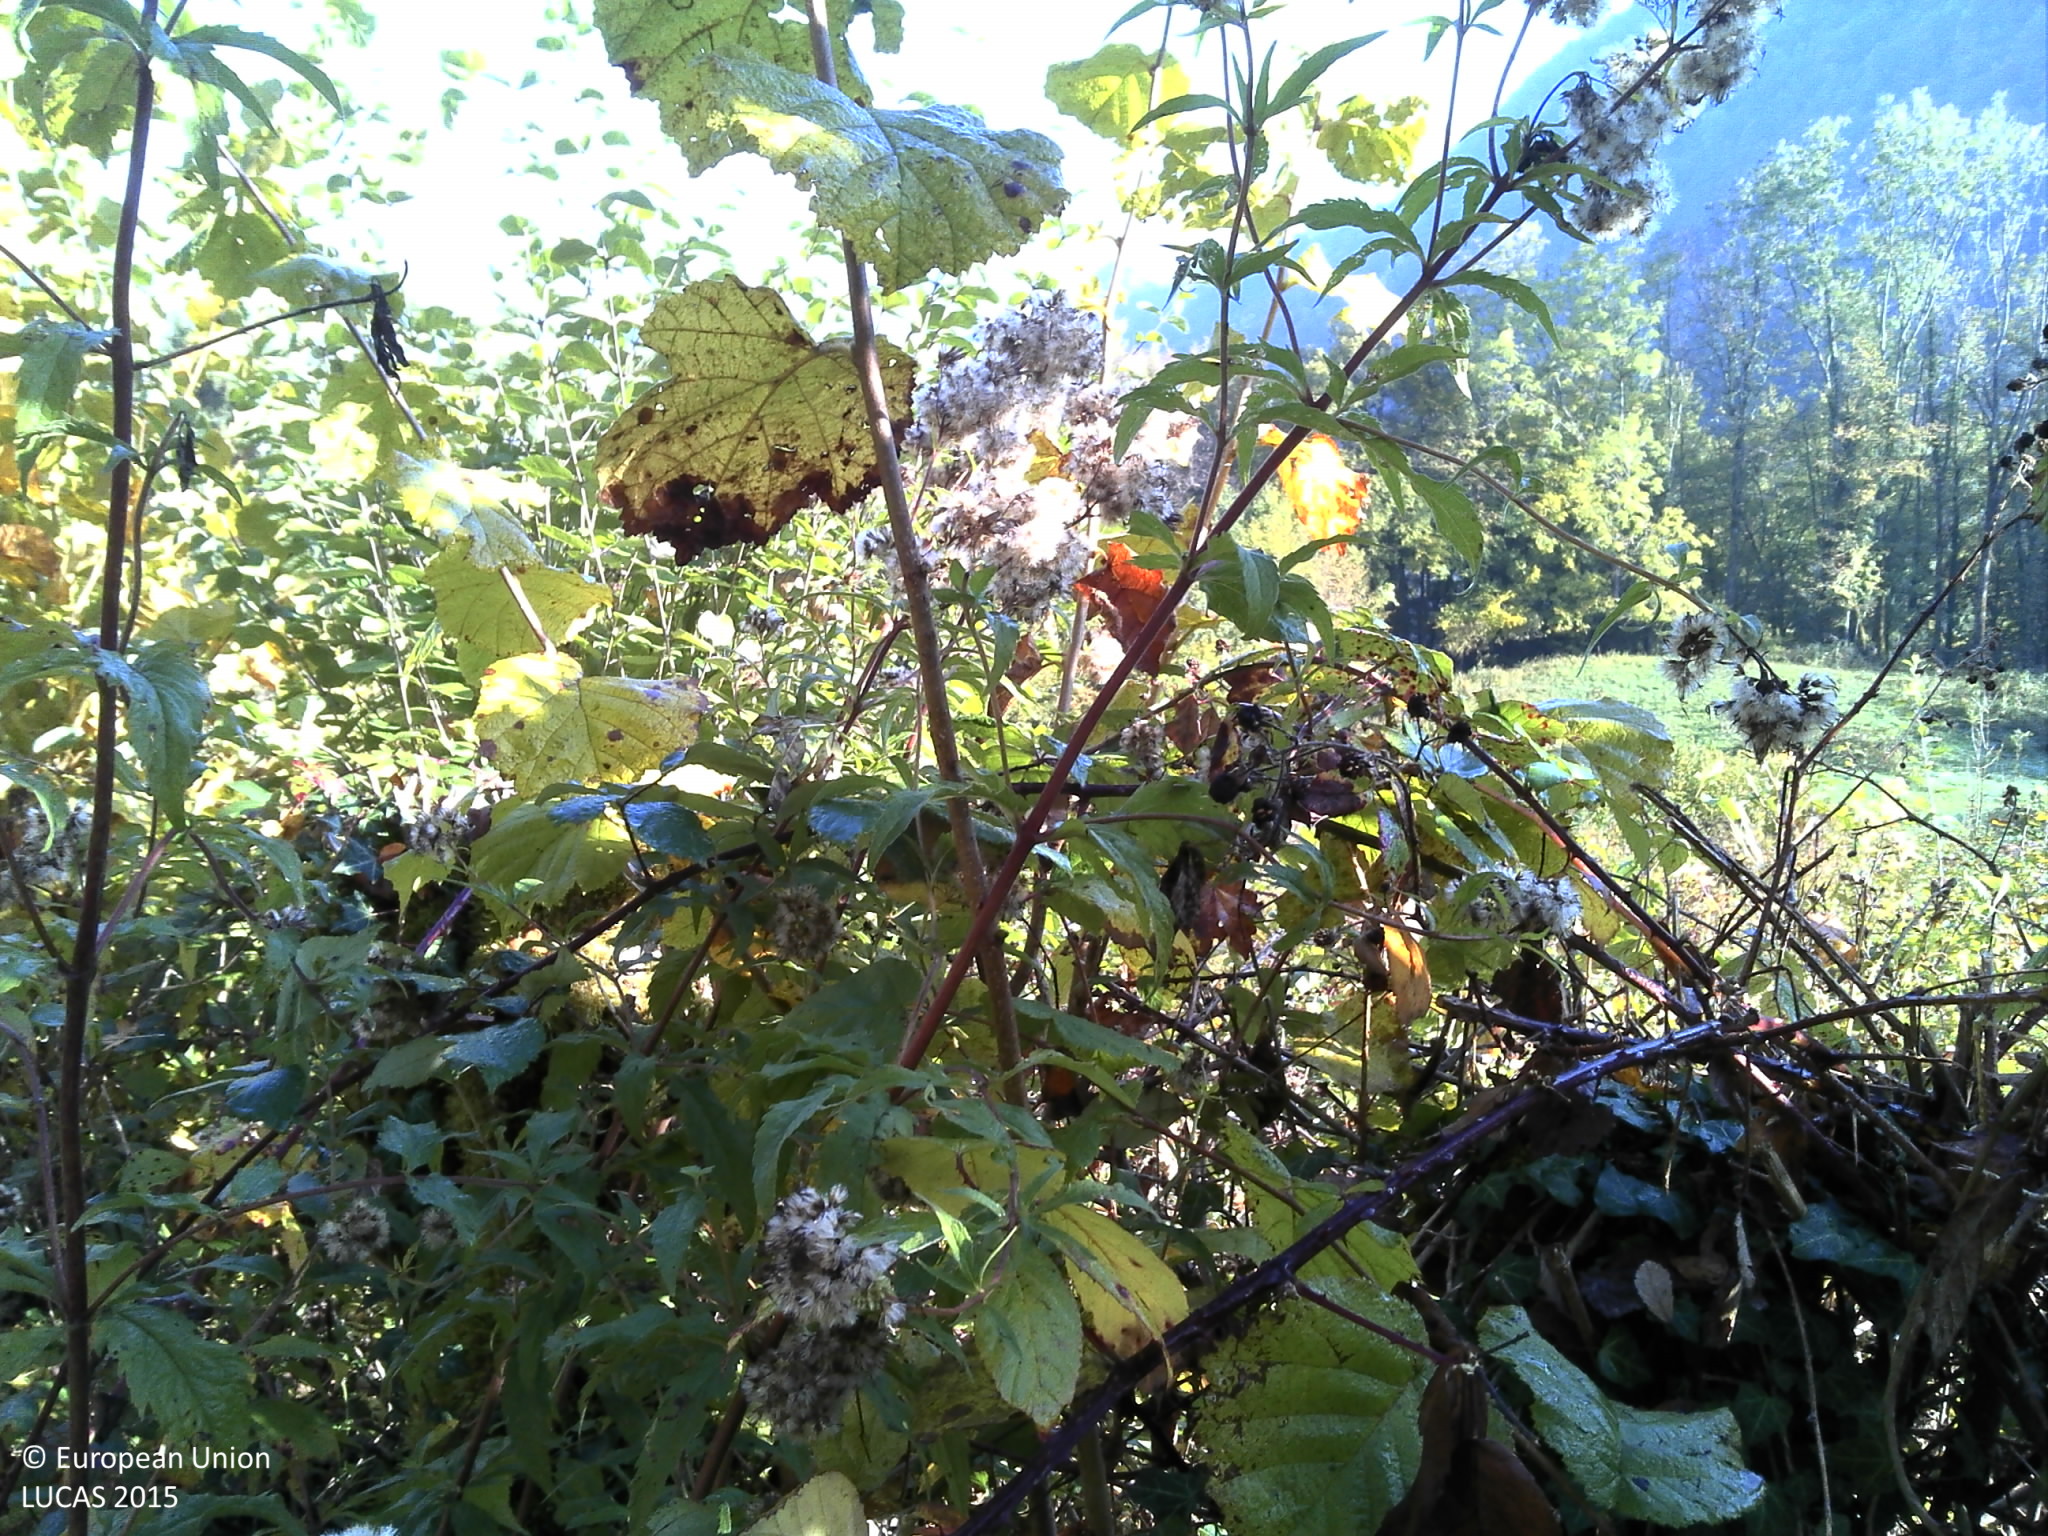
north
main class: Shrubland
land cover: Shrubland with sparse tree cover
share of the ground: > 75 %
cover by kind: shrubs 95 %, broadleaved forest trees 5 %
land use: Semi-natural and natural areas not in use
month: October
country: FR
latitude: 45.9286
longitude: 5.4257
